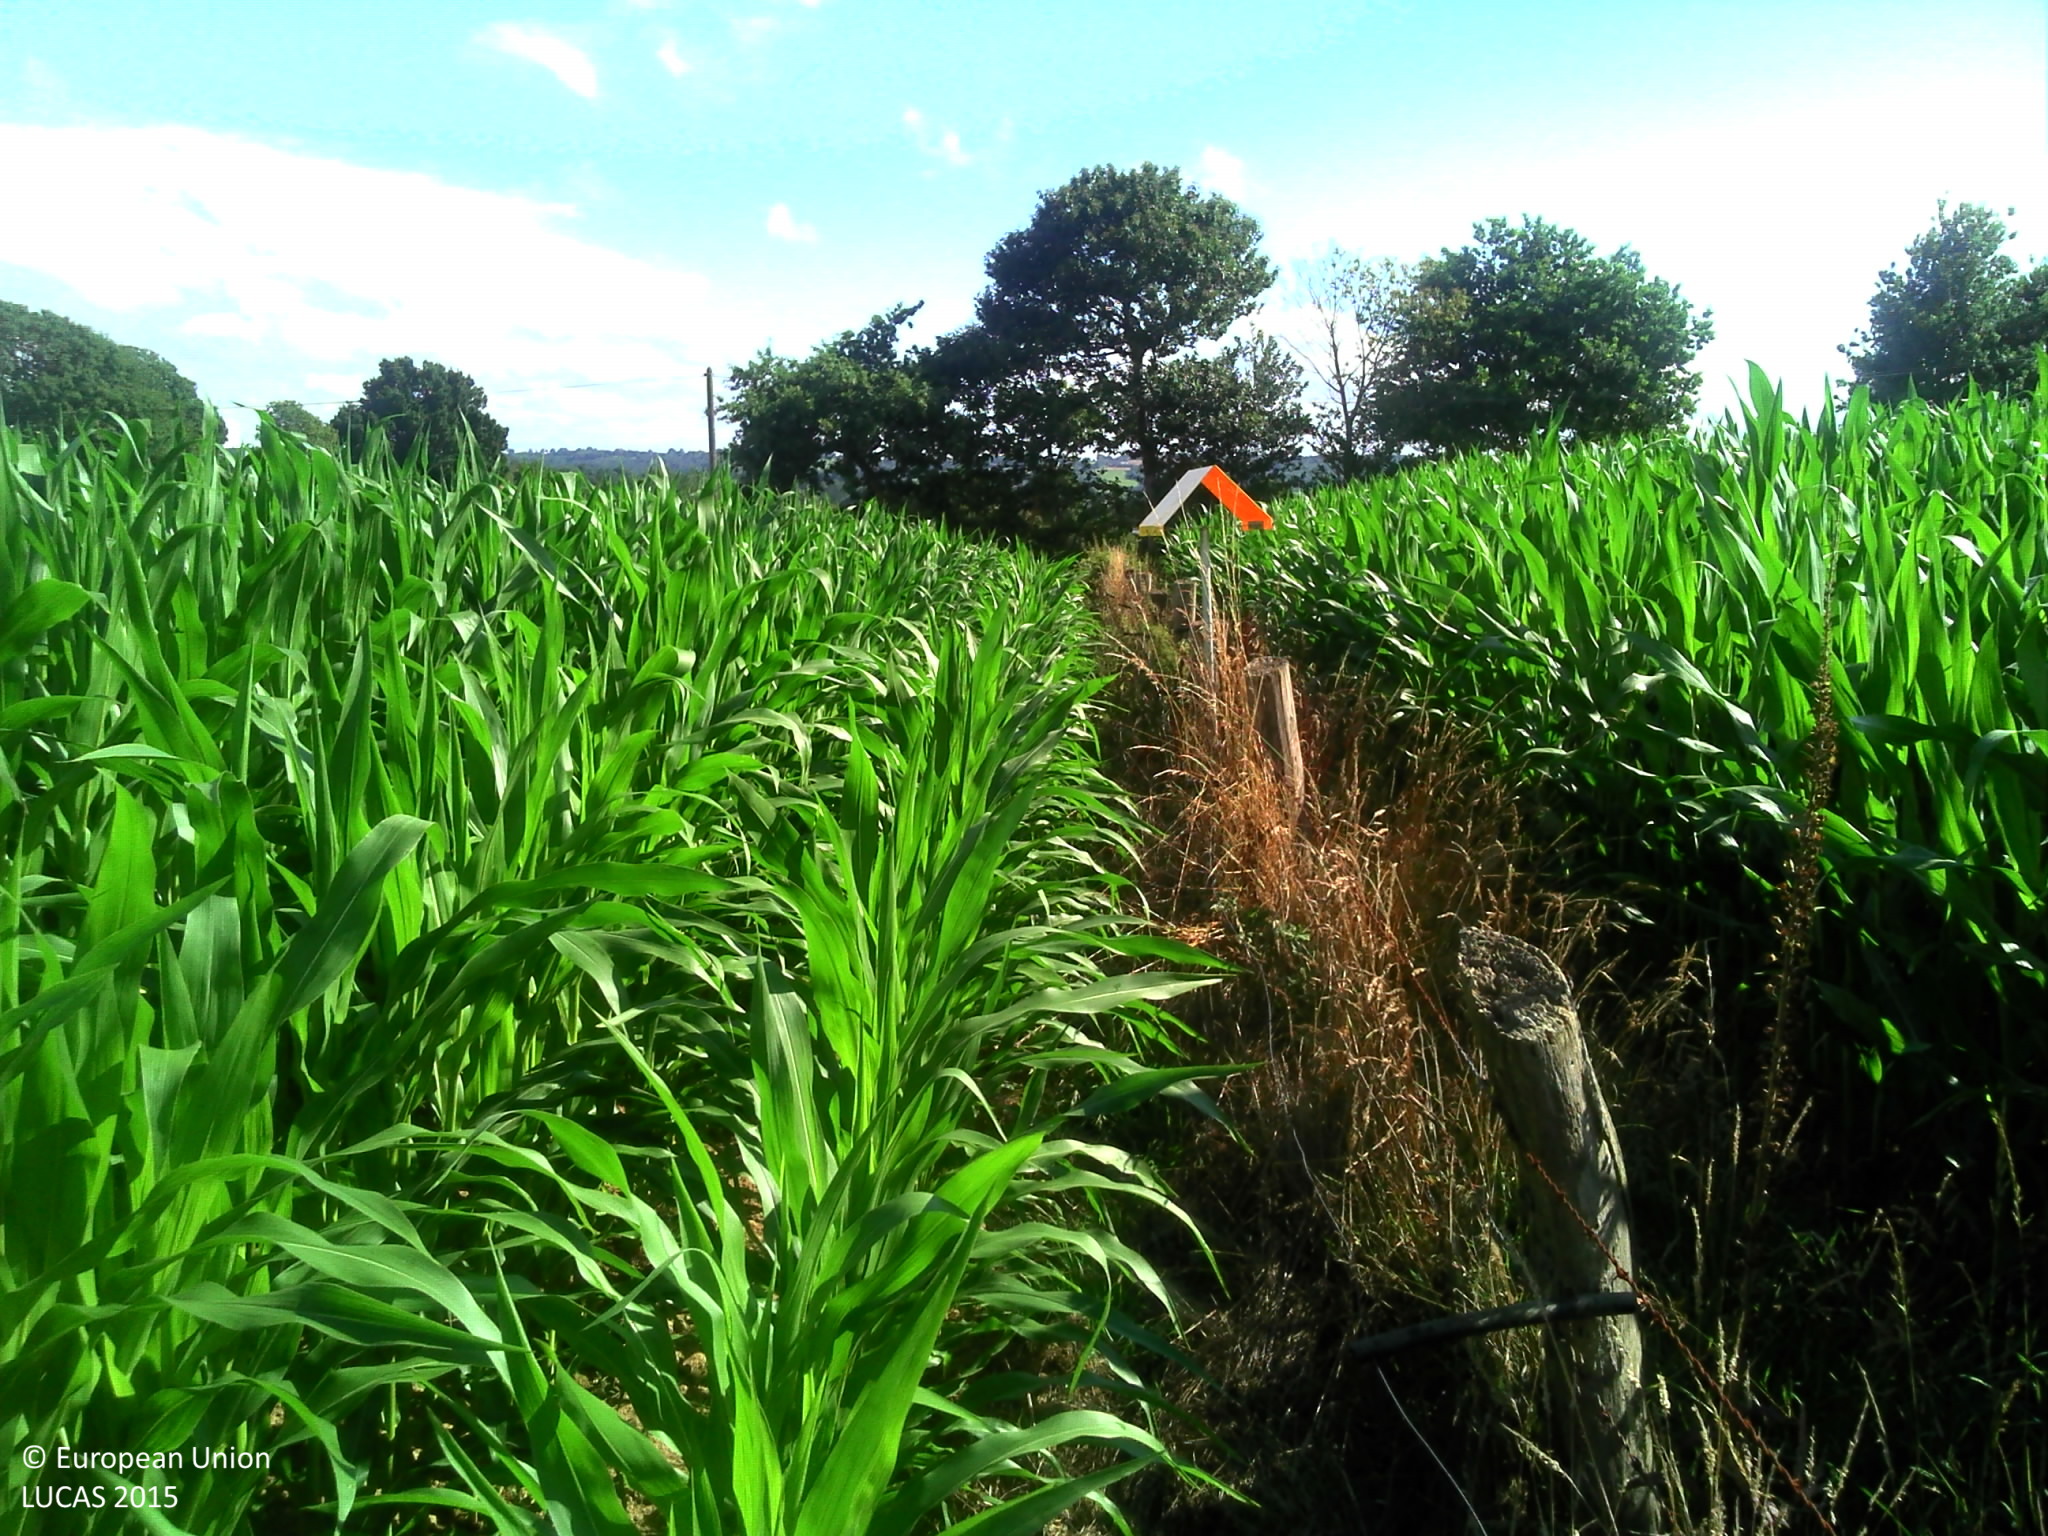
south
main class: Cropland
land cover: Maize
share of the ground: > 75 %
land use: Agriculture (excluding fallow land and kitchen gardens)
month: July
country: FR
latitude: 48.7316
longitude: -1.2887
